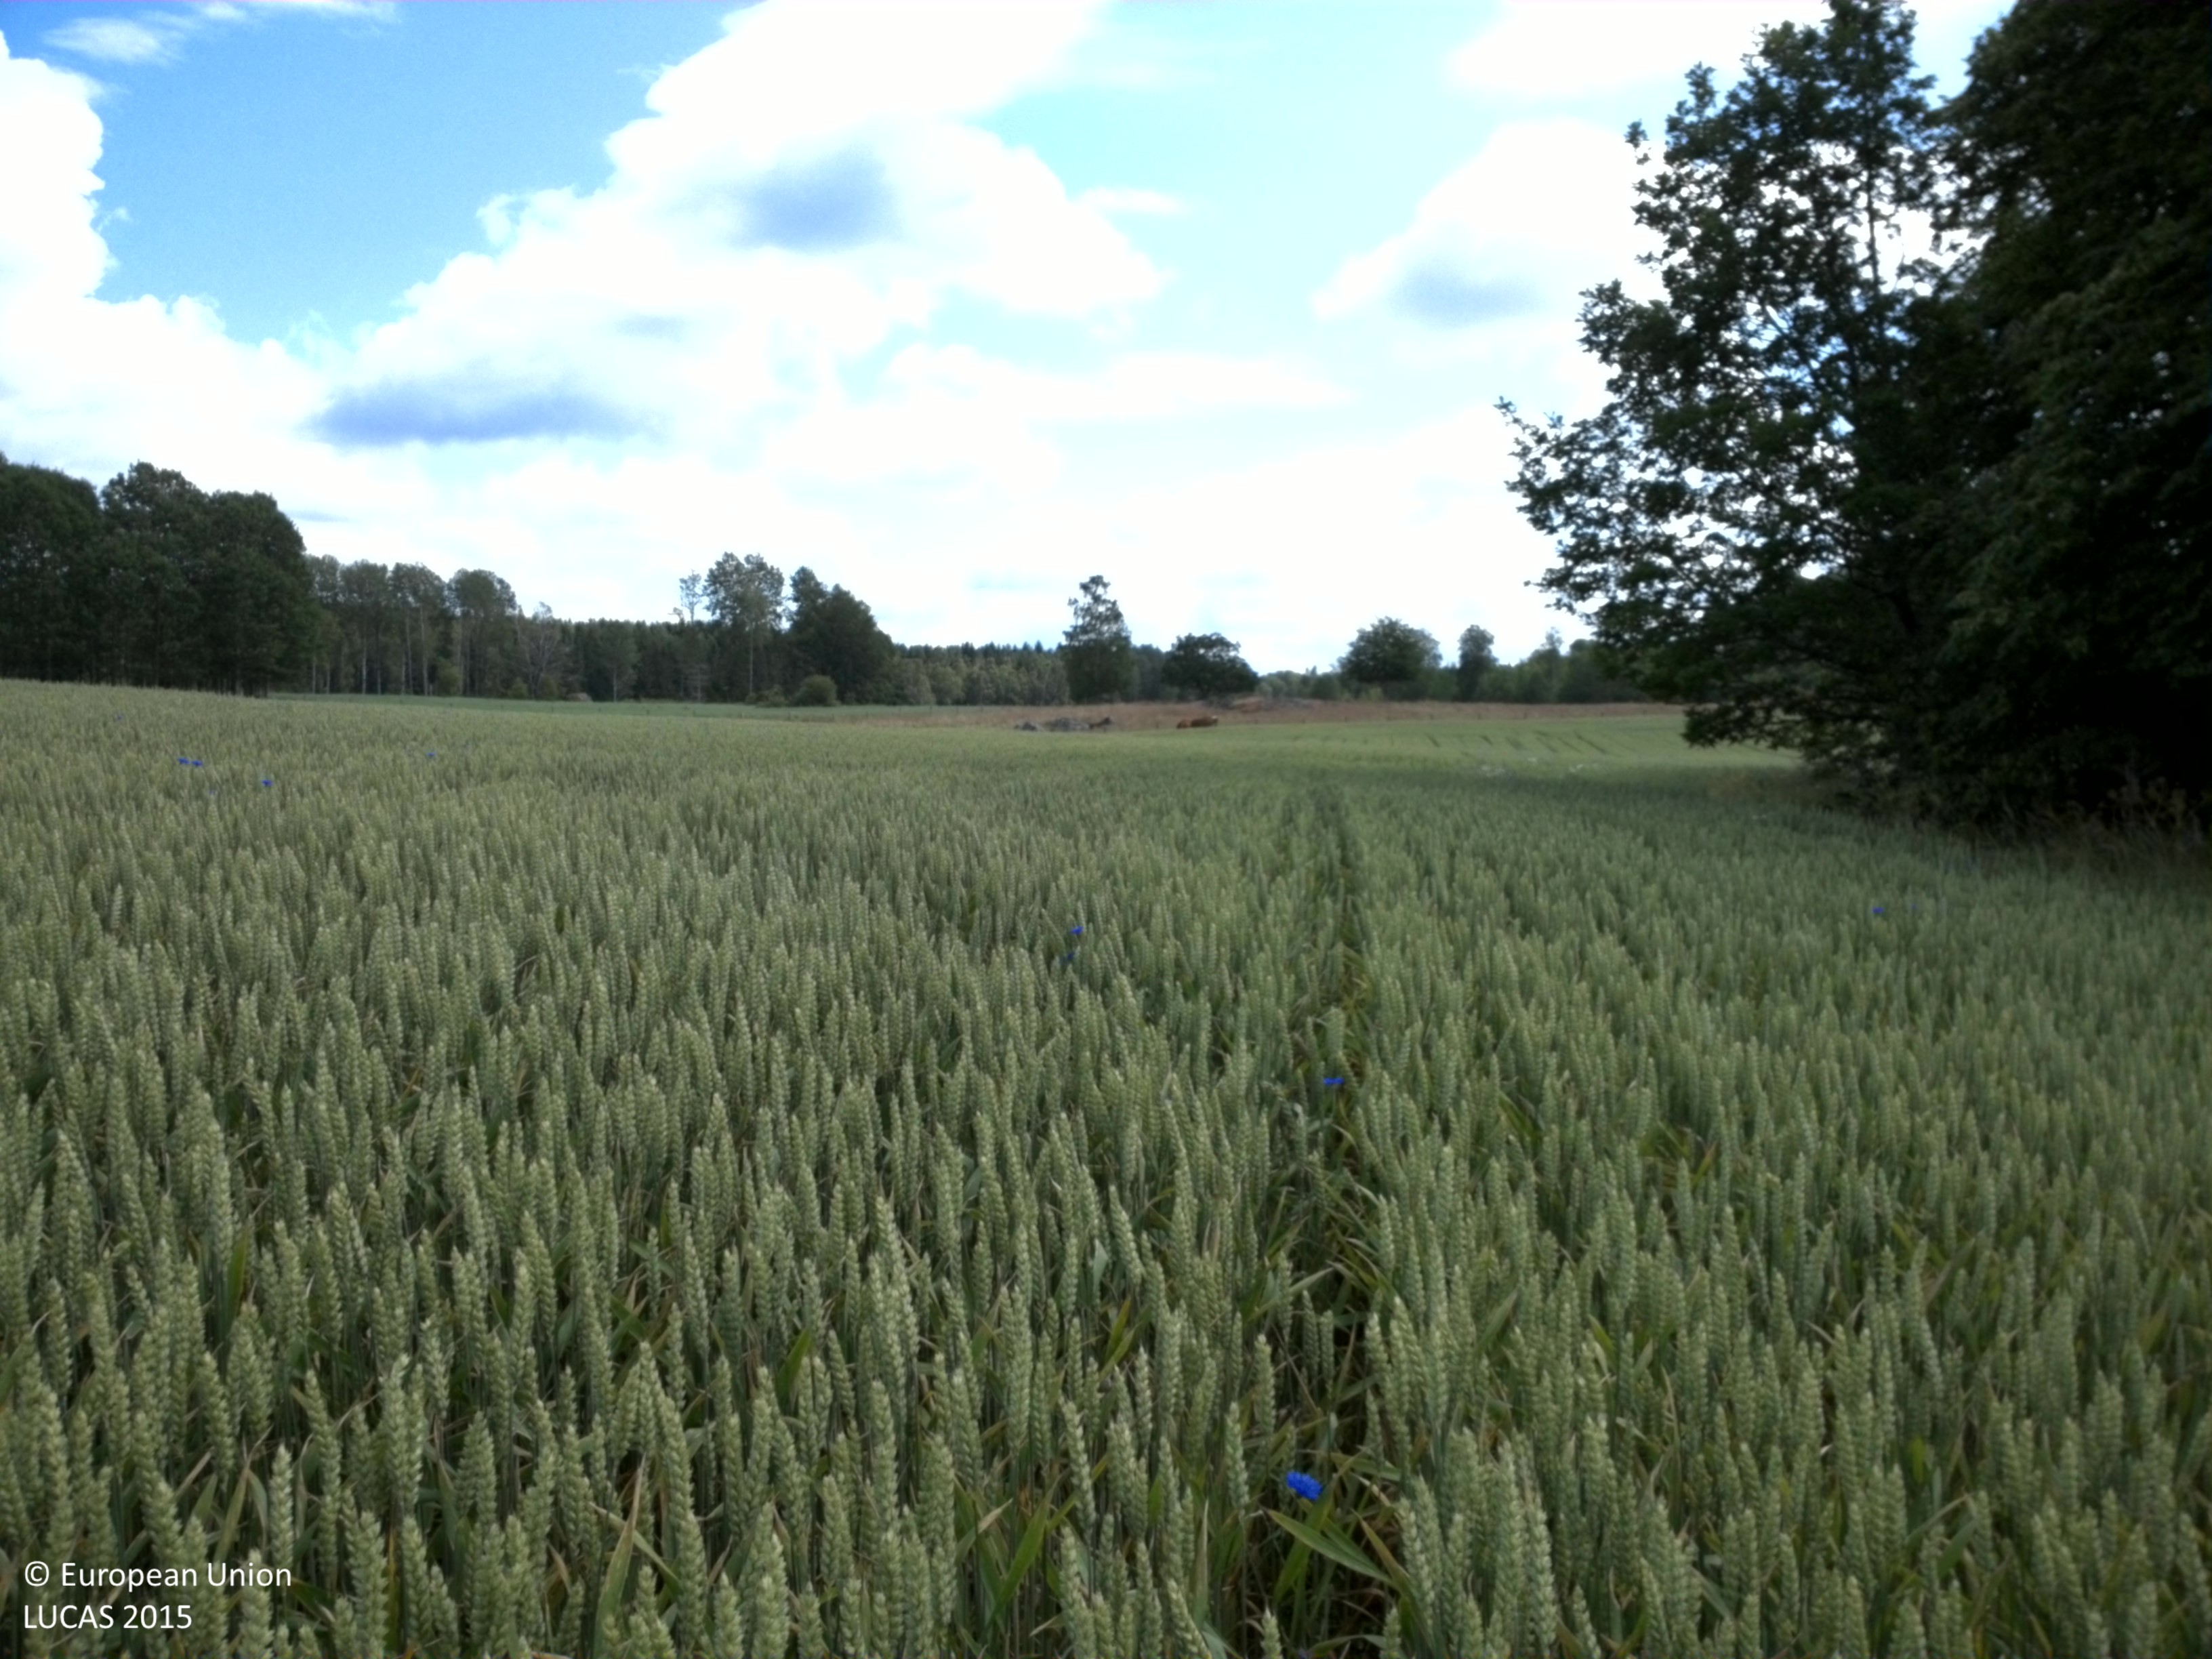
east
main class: Cropland
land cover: Common wheat
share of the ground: > 75 %
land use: Agriculture (excluding fallow land and kitchen gardens)
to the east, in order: Common wheat; Fences; Grassland with sparse tree/shrub cover; Fences; Oats
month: July
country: SE
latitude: 58.7339
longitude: 15.6077
